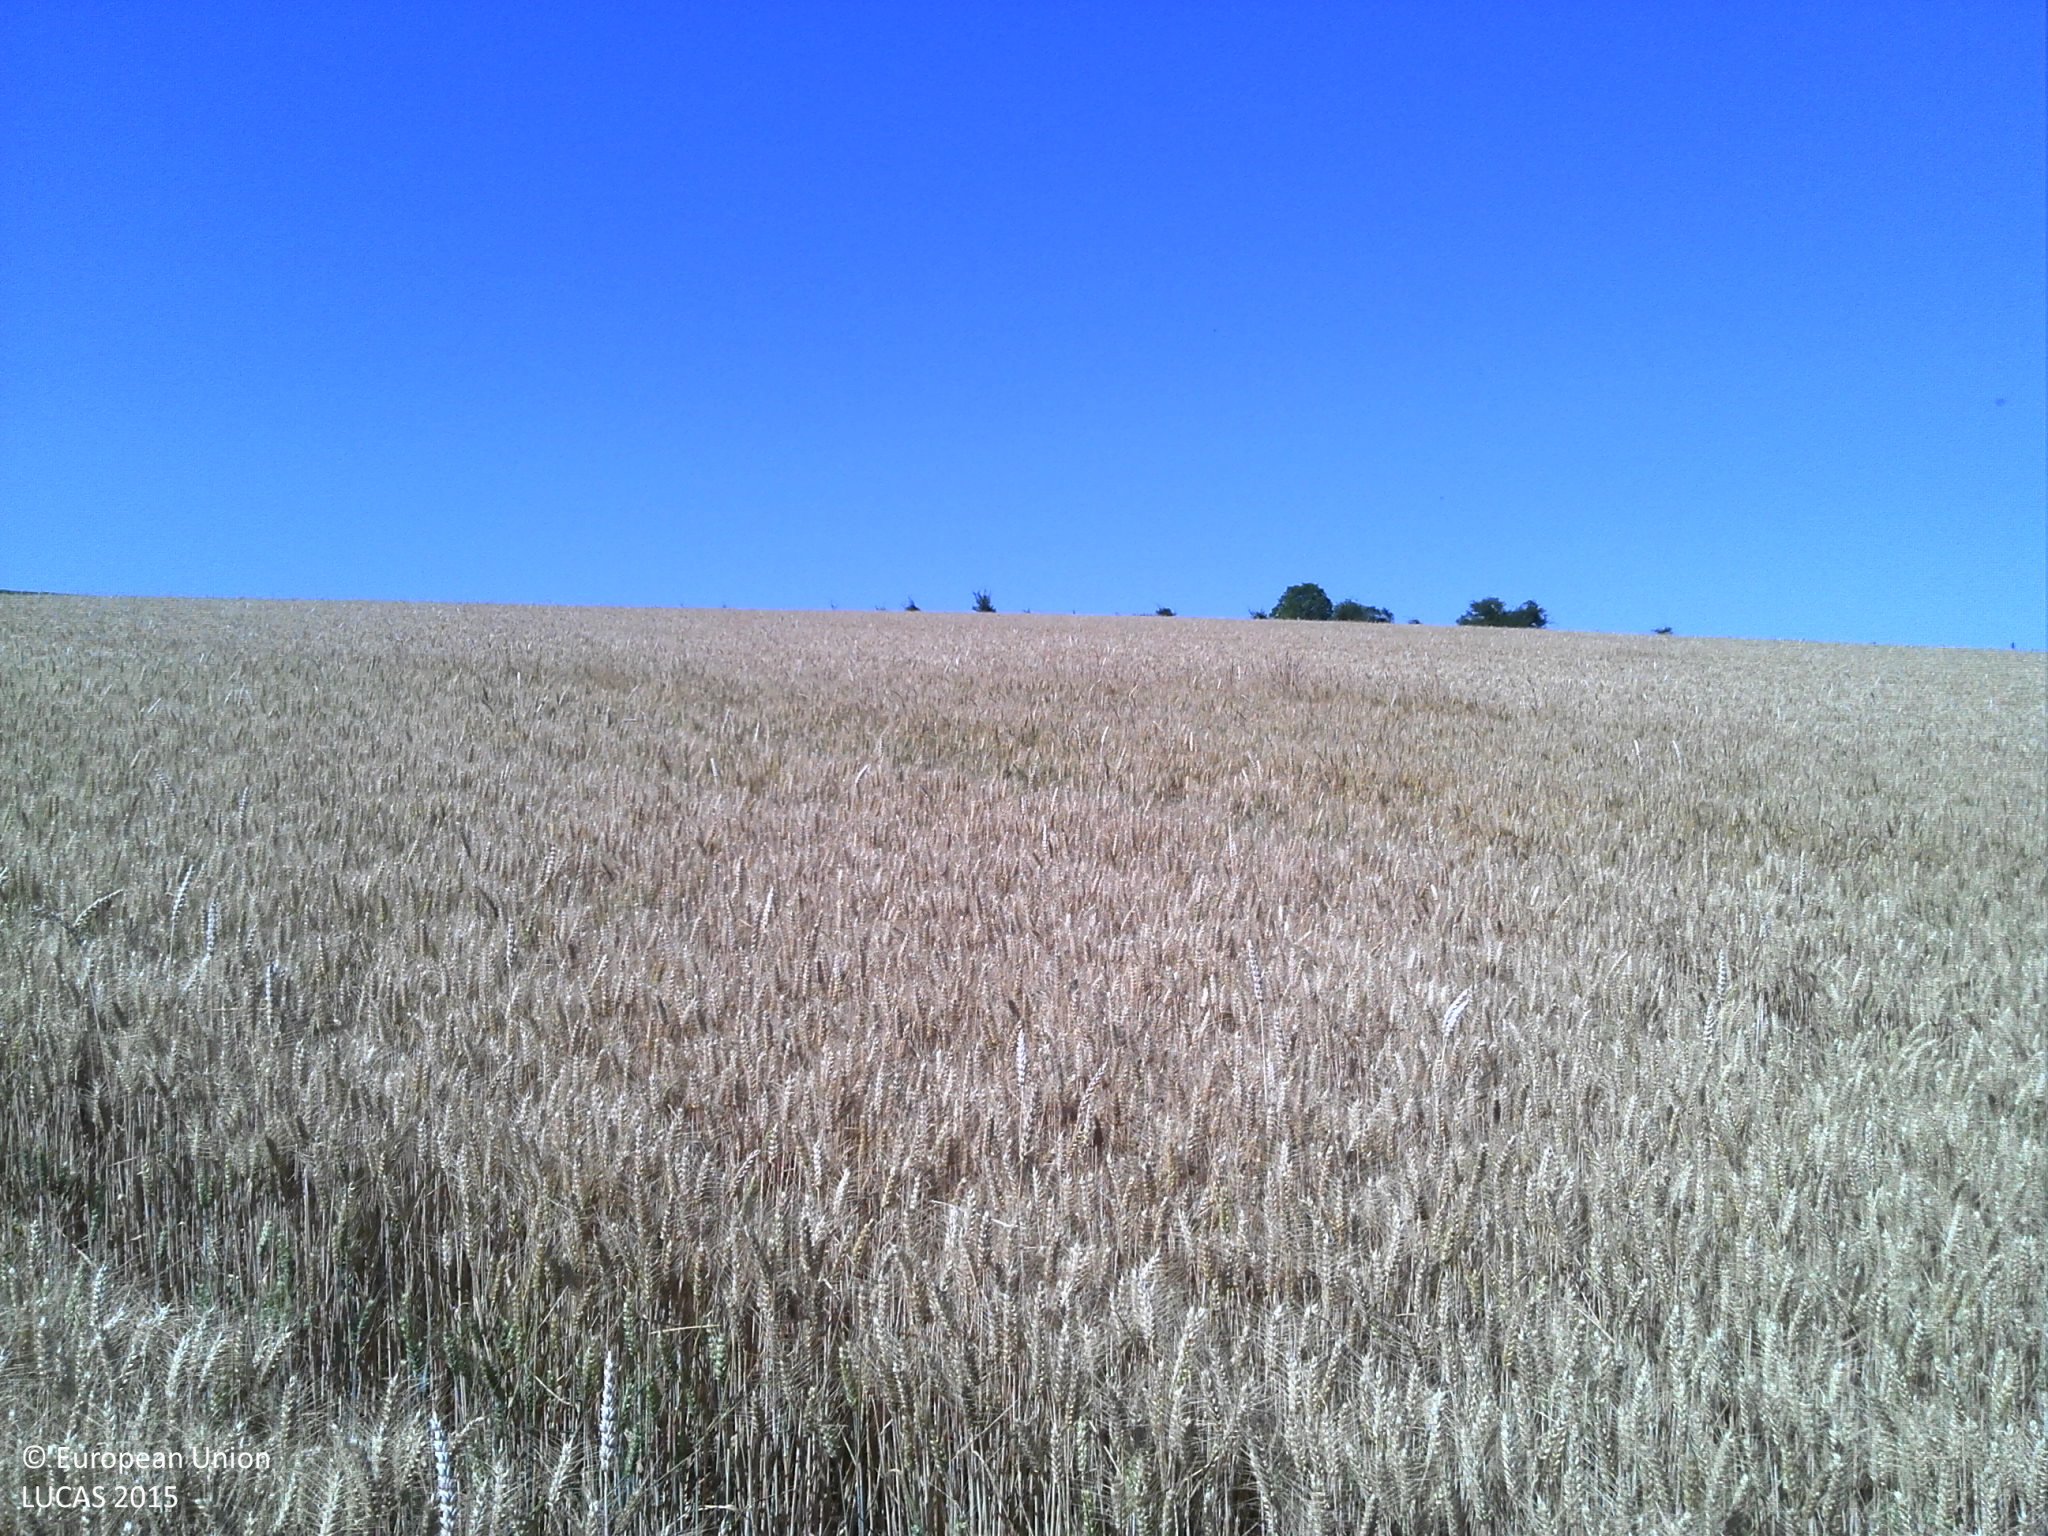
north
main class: Cropland
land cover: Common wheat
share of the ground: > 75 %
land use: Agriculture (excluding fallow land and kitchen gardens)
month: July
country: FR
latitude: 49.5232
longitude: 4.7612
